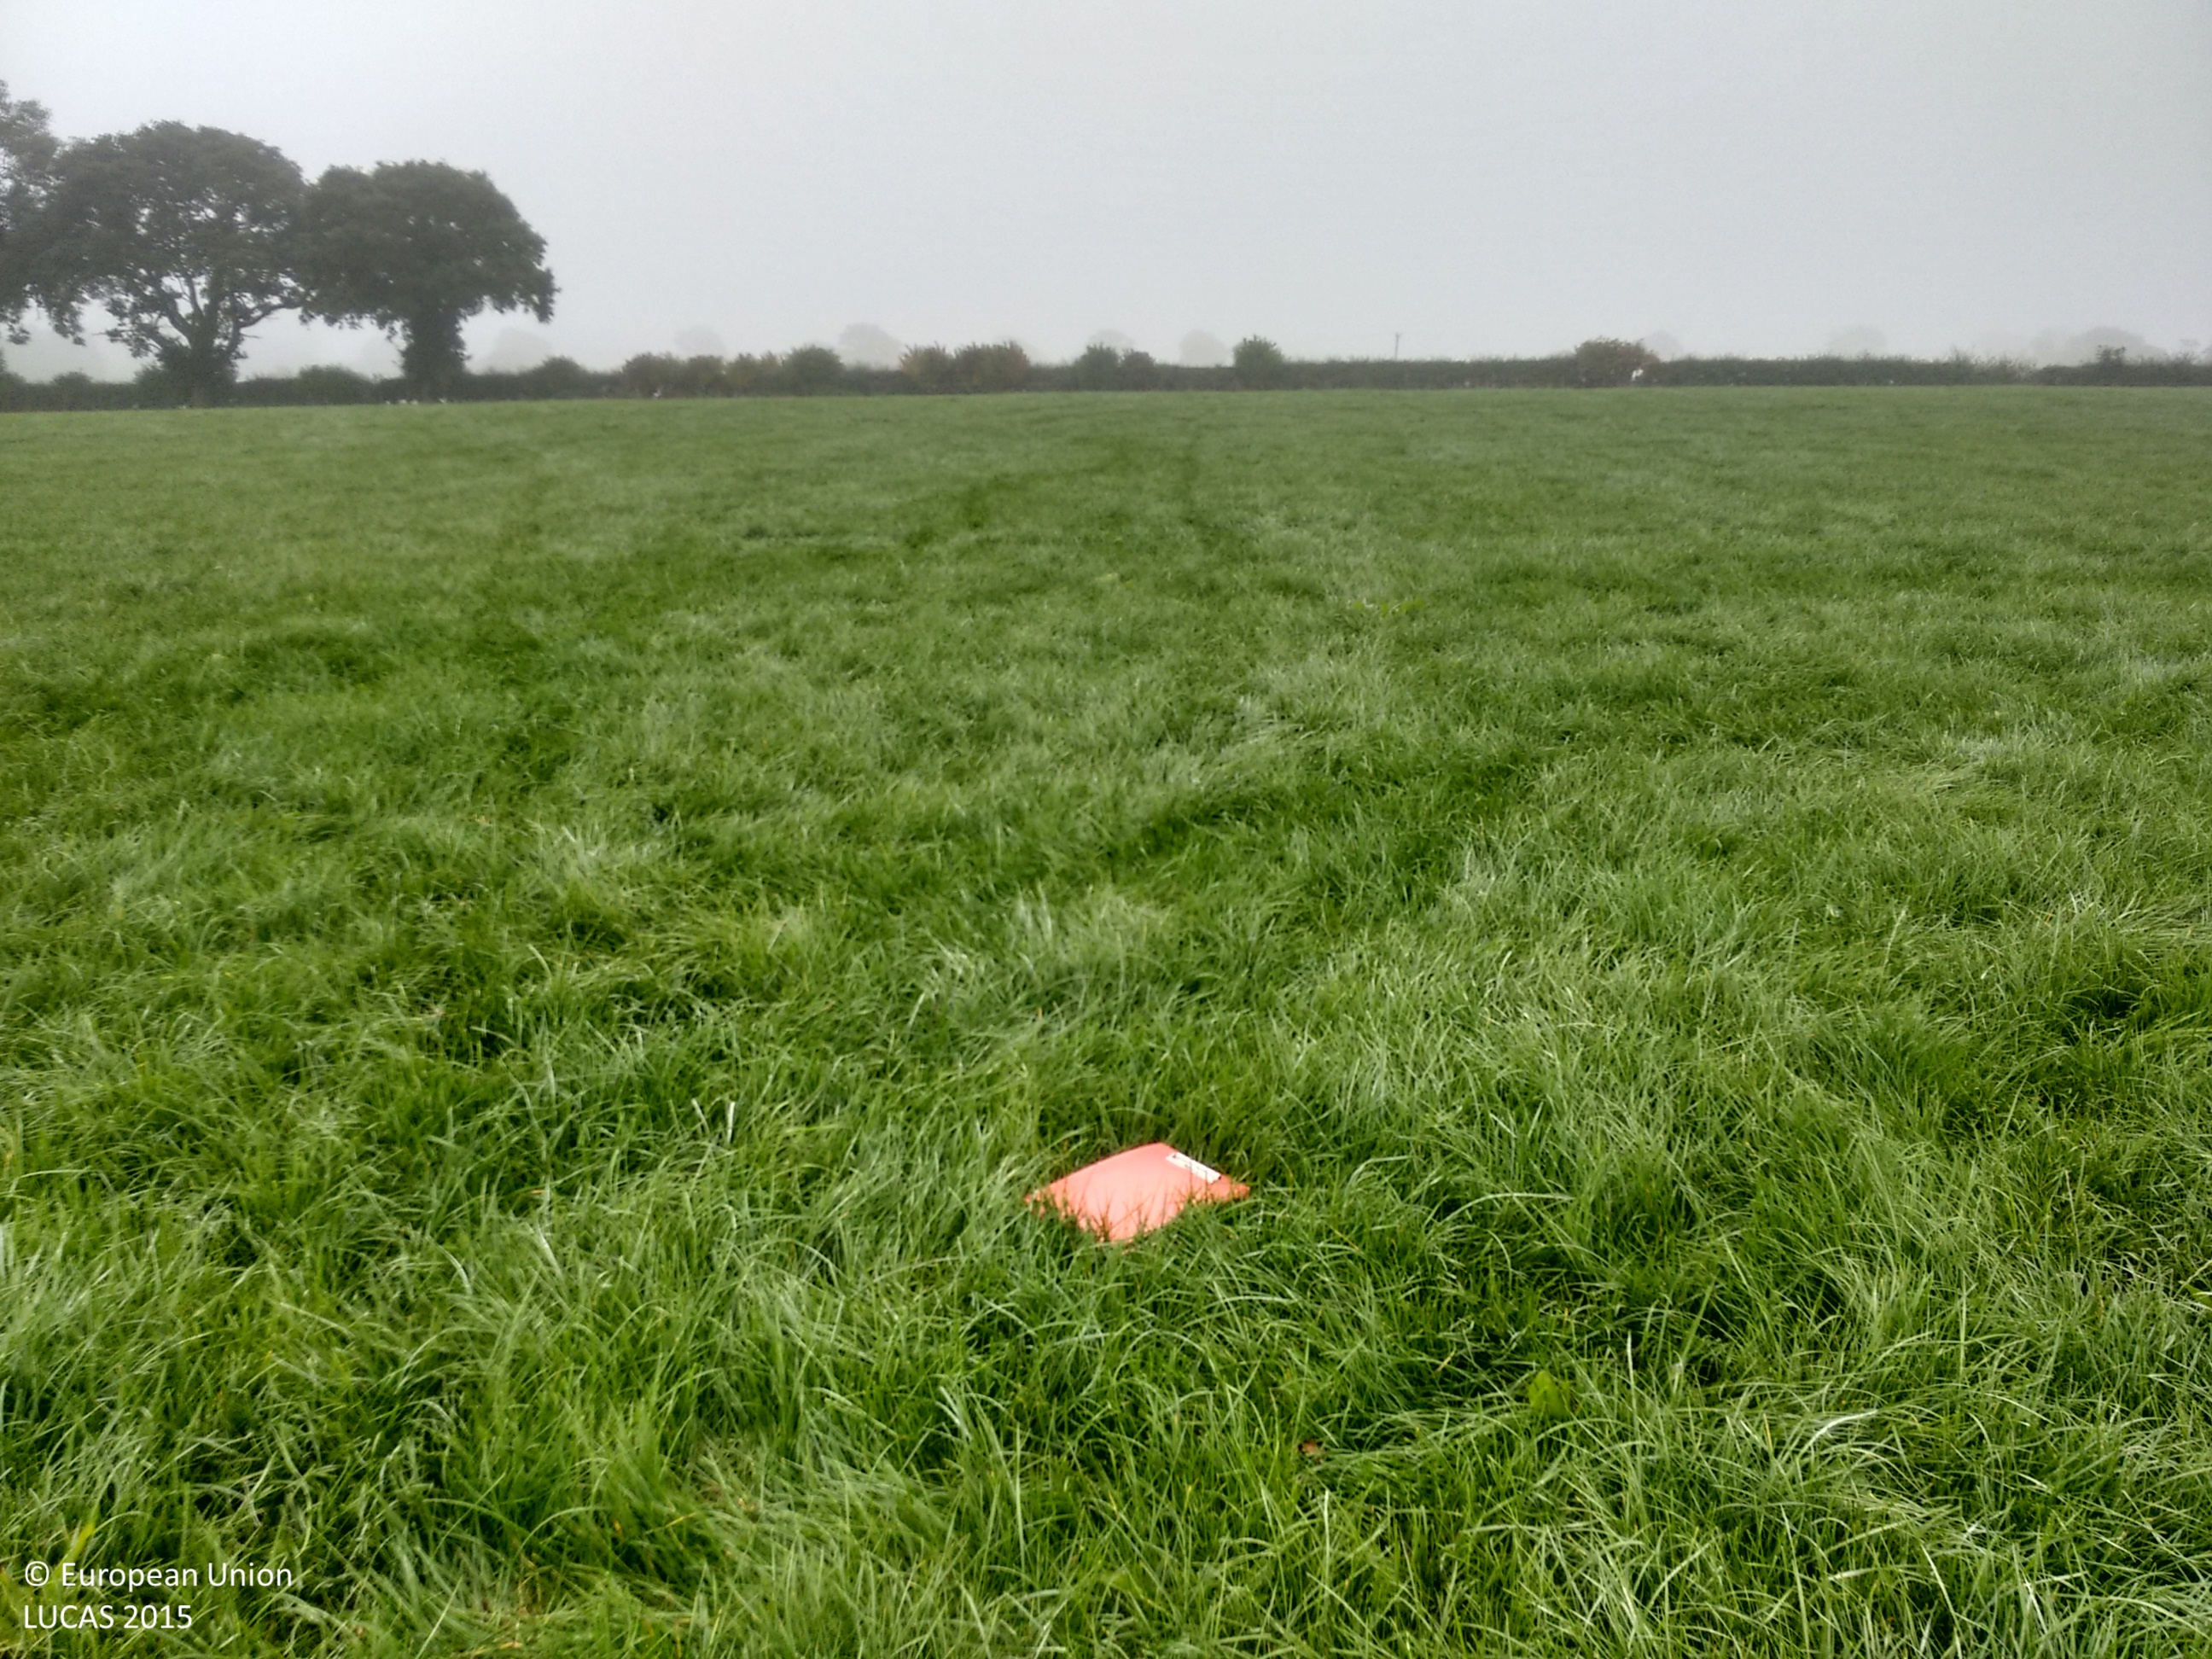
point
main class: Grassland
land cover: Grassland without tree/shrub cover
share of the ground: > 75 %
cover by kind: herbaceous plants 100 %
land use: Agriculture (excluding fallow land and kitchen gardens)
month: September
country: GB
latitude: 52.7895
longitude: -2.9903
